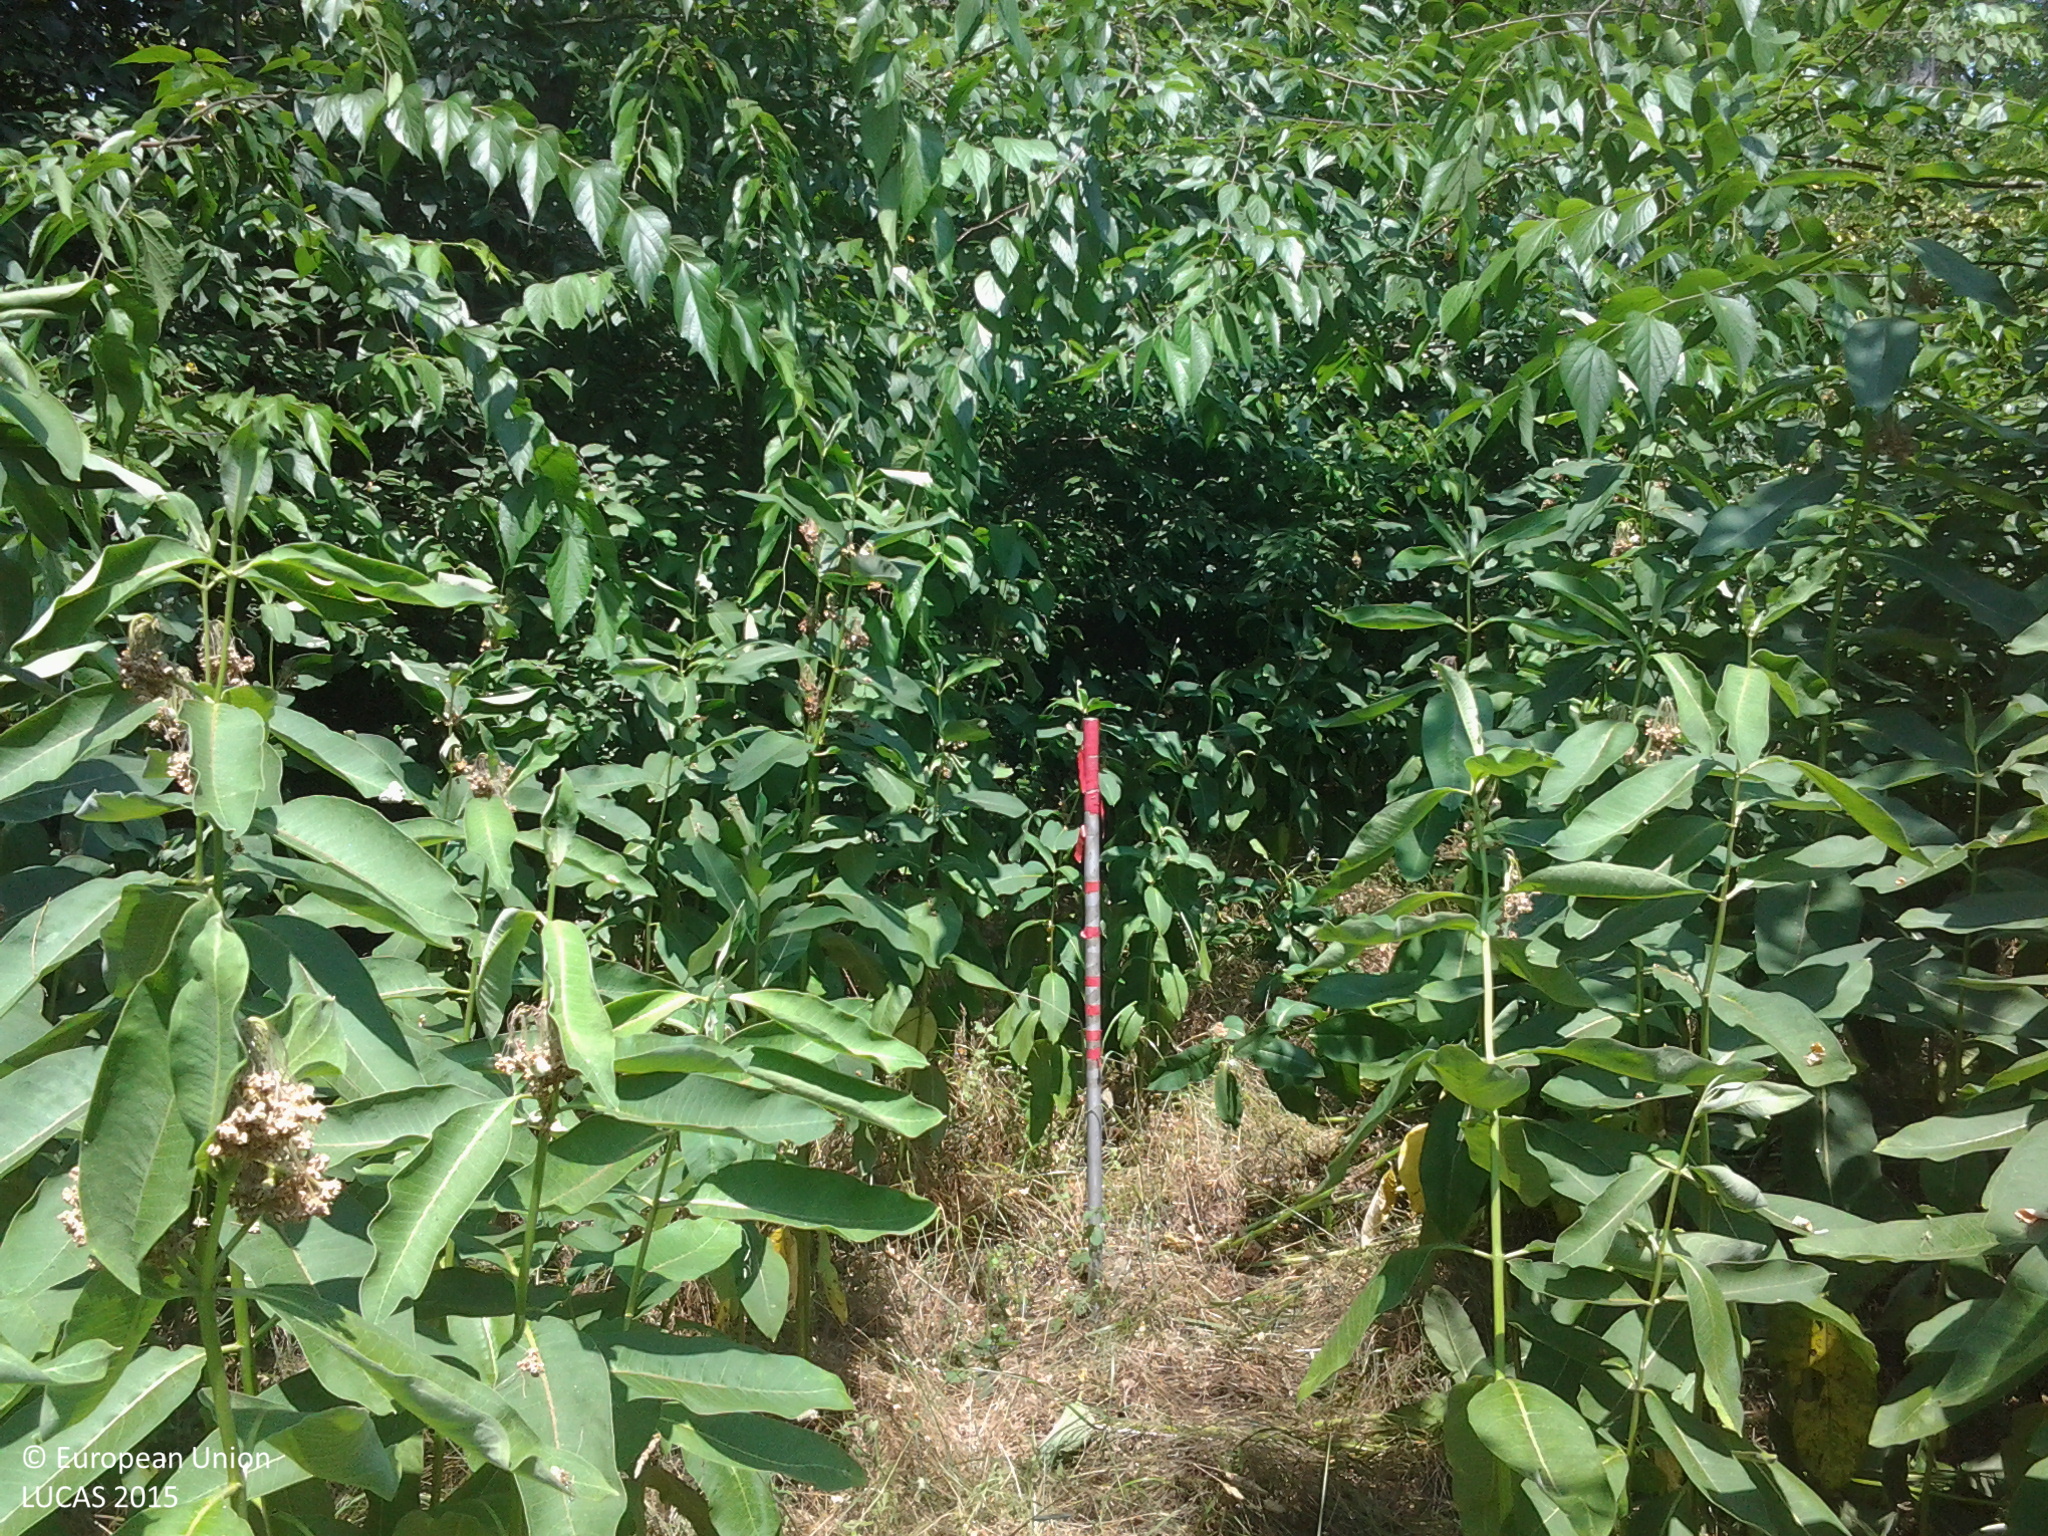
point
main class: Woodland
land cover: Pine dominated coniferous woodland
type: hemiboreal forest and nemoral coniferous forest and mixed broadleaved-coniferous forest
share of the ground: 50 - 75 %
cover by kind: coniferous forest trees 65 %, herbaceous plants 15 %, broadleaved forest trees 10 %, shrubs 10 %
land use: Forestry
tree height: > 5 m
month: July
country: HU
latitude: 46.6550
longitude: 19.6763
